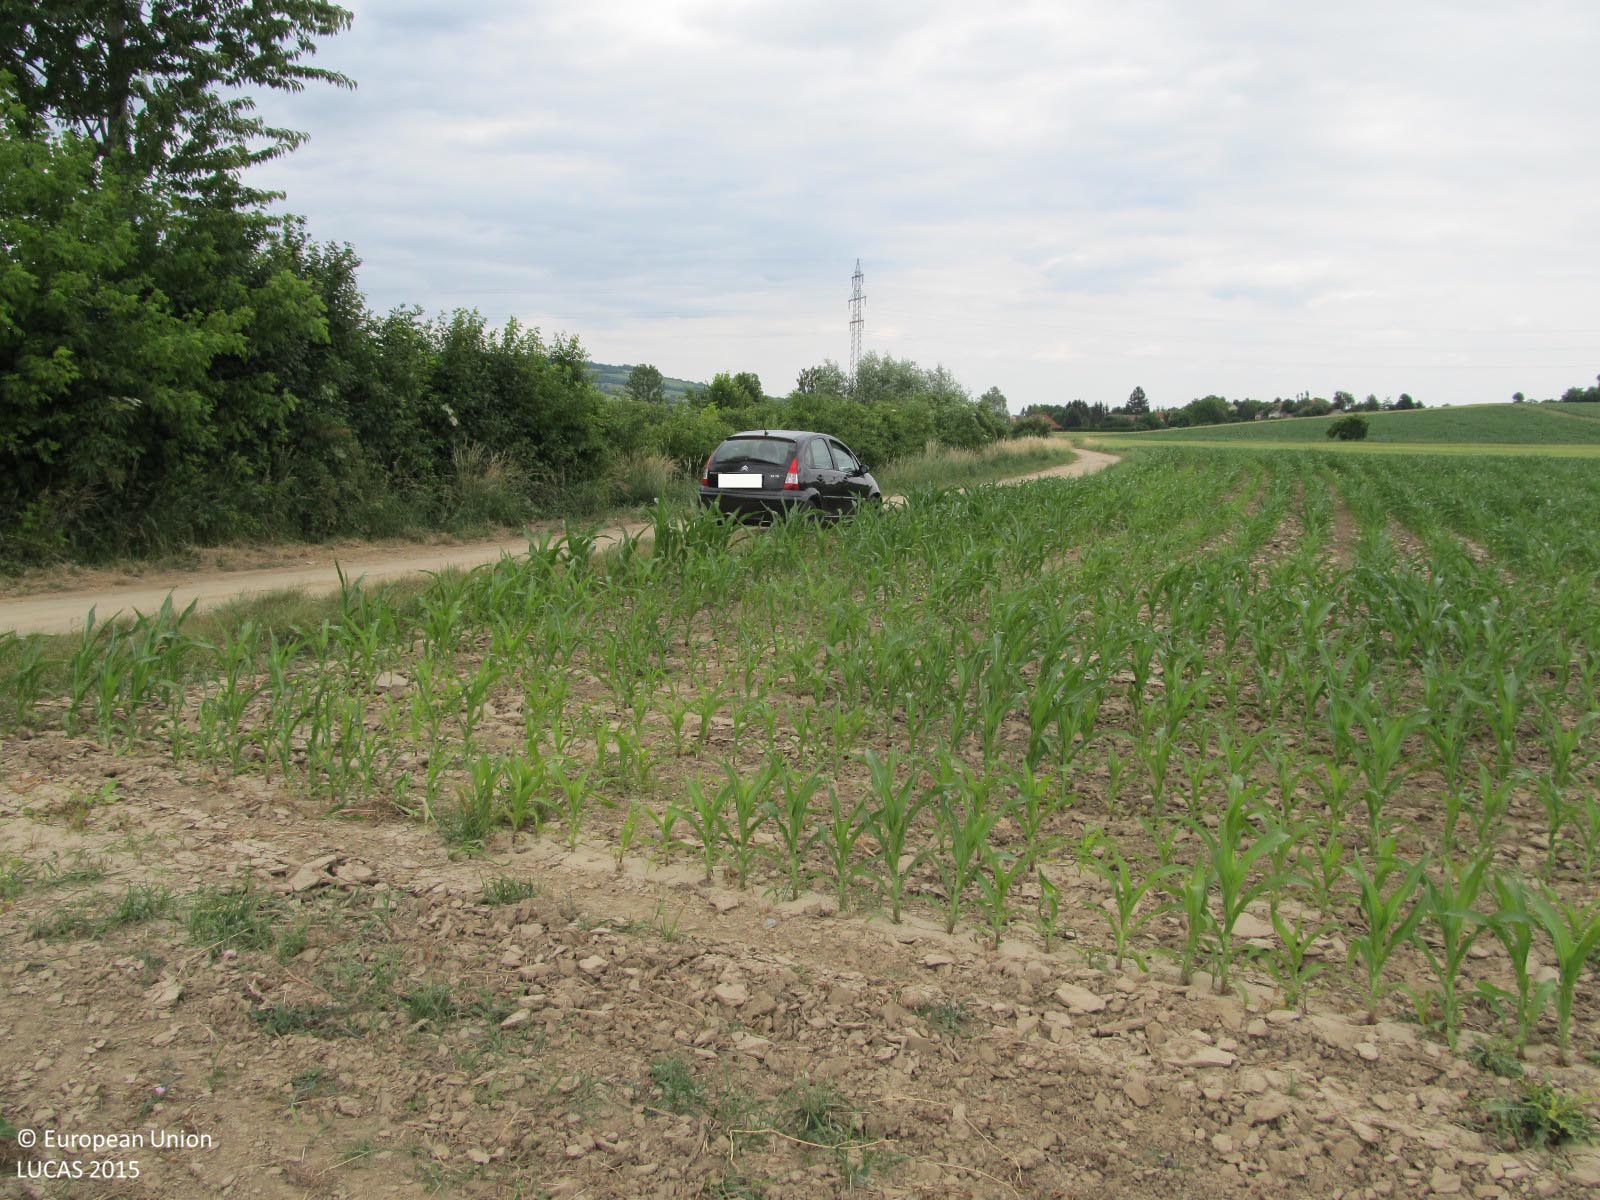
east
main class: Cropland
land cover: Other fibre and oleaginous crops
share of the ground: < 10 %
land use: Agriculture (excluding fallow land and kitchen gardens)
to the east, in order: Other fibre and oleaginous crops; Maize; Paved roads, cycling and walking lanes; Grass margins; Shrubland with sparse tree cover; Rivers and streams; Shrubland with sparse tree cover; Tracks; Grass margins; Sugar beet; Grass margins; Tracks; Lines of trees; Ditches and canals; Grass margins; Maize
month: June
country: AT
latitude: 48.5067
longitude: 16.0819
